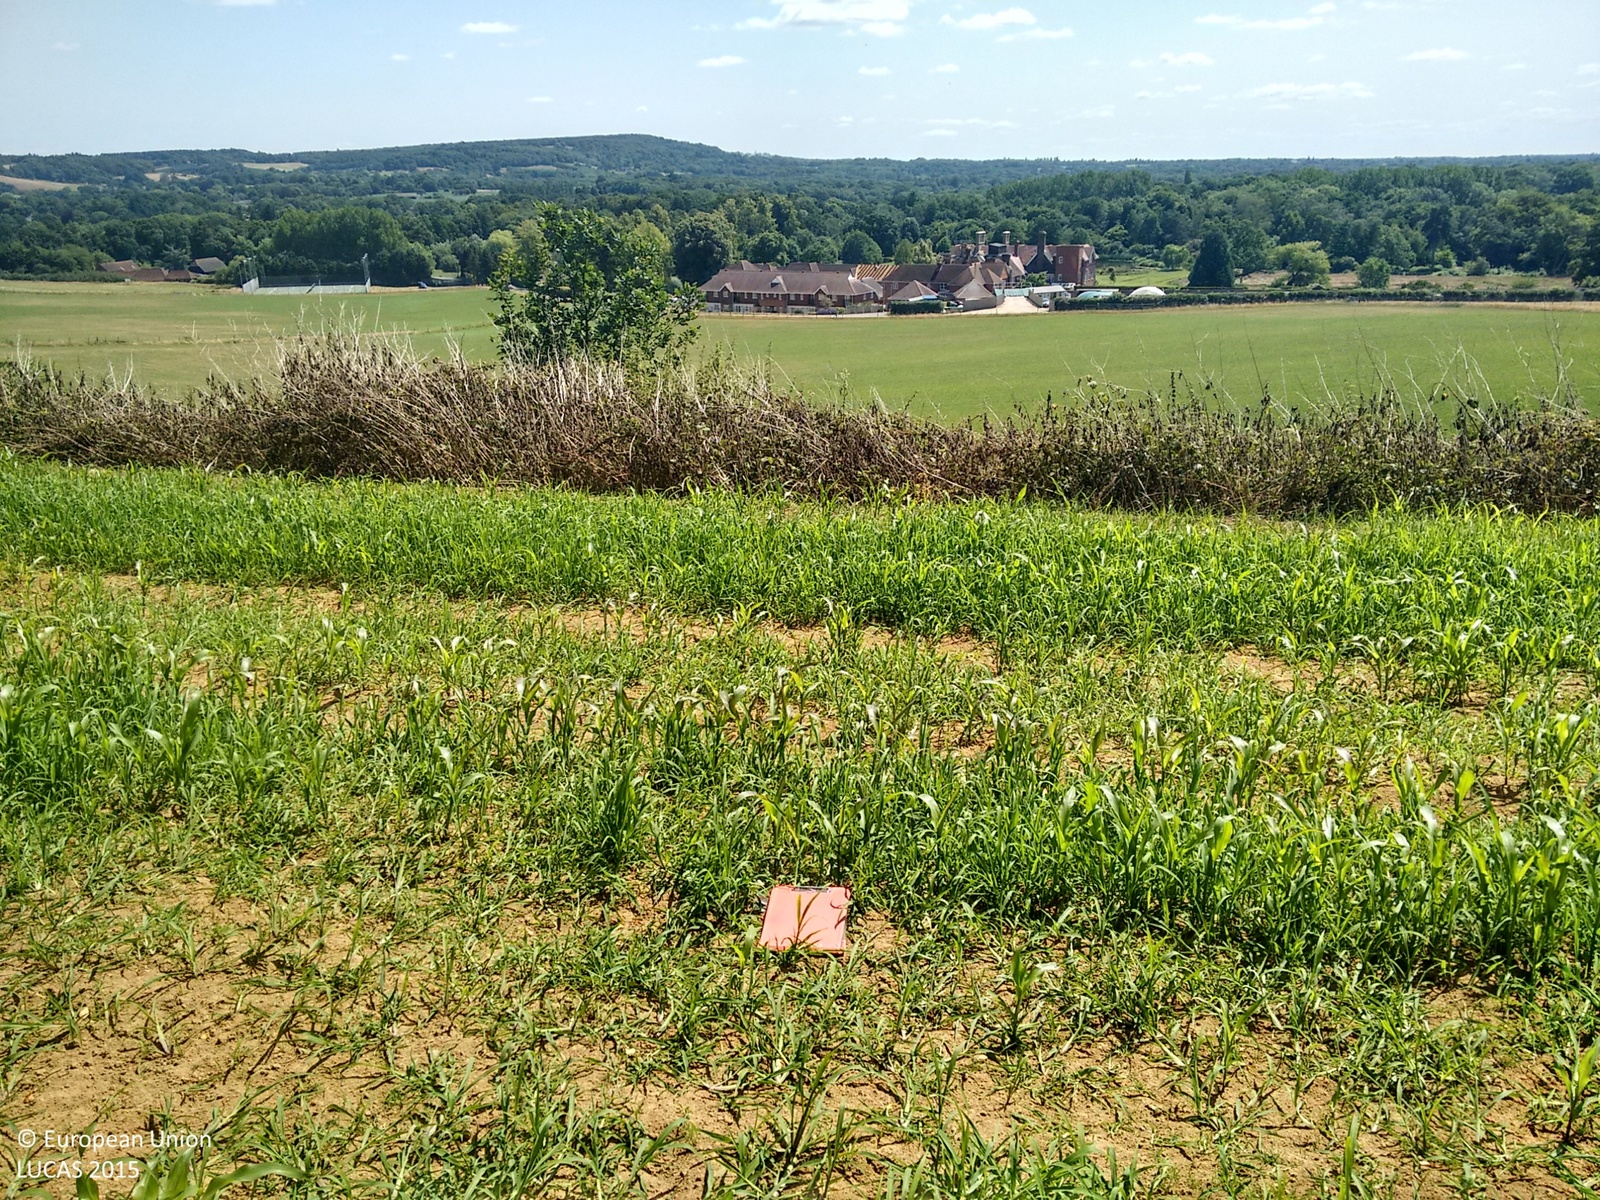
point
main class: Cropland
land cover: Maize
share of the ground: 10 - 25 %
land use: Agriculture (excluding fallow land and kitchen gardens)
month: July
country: GB
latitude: 51.1802
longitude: -0.5534
